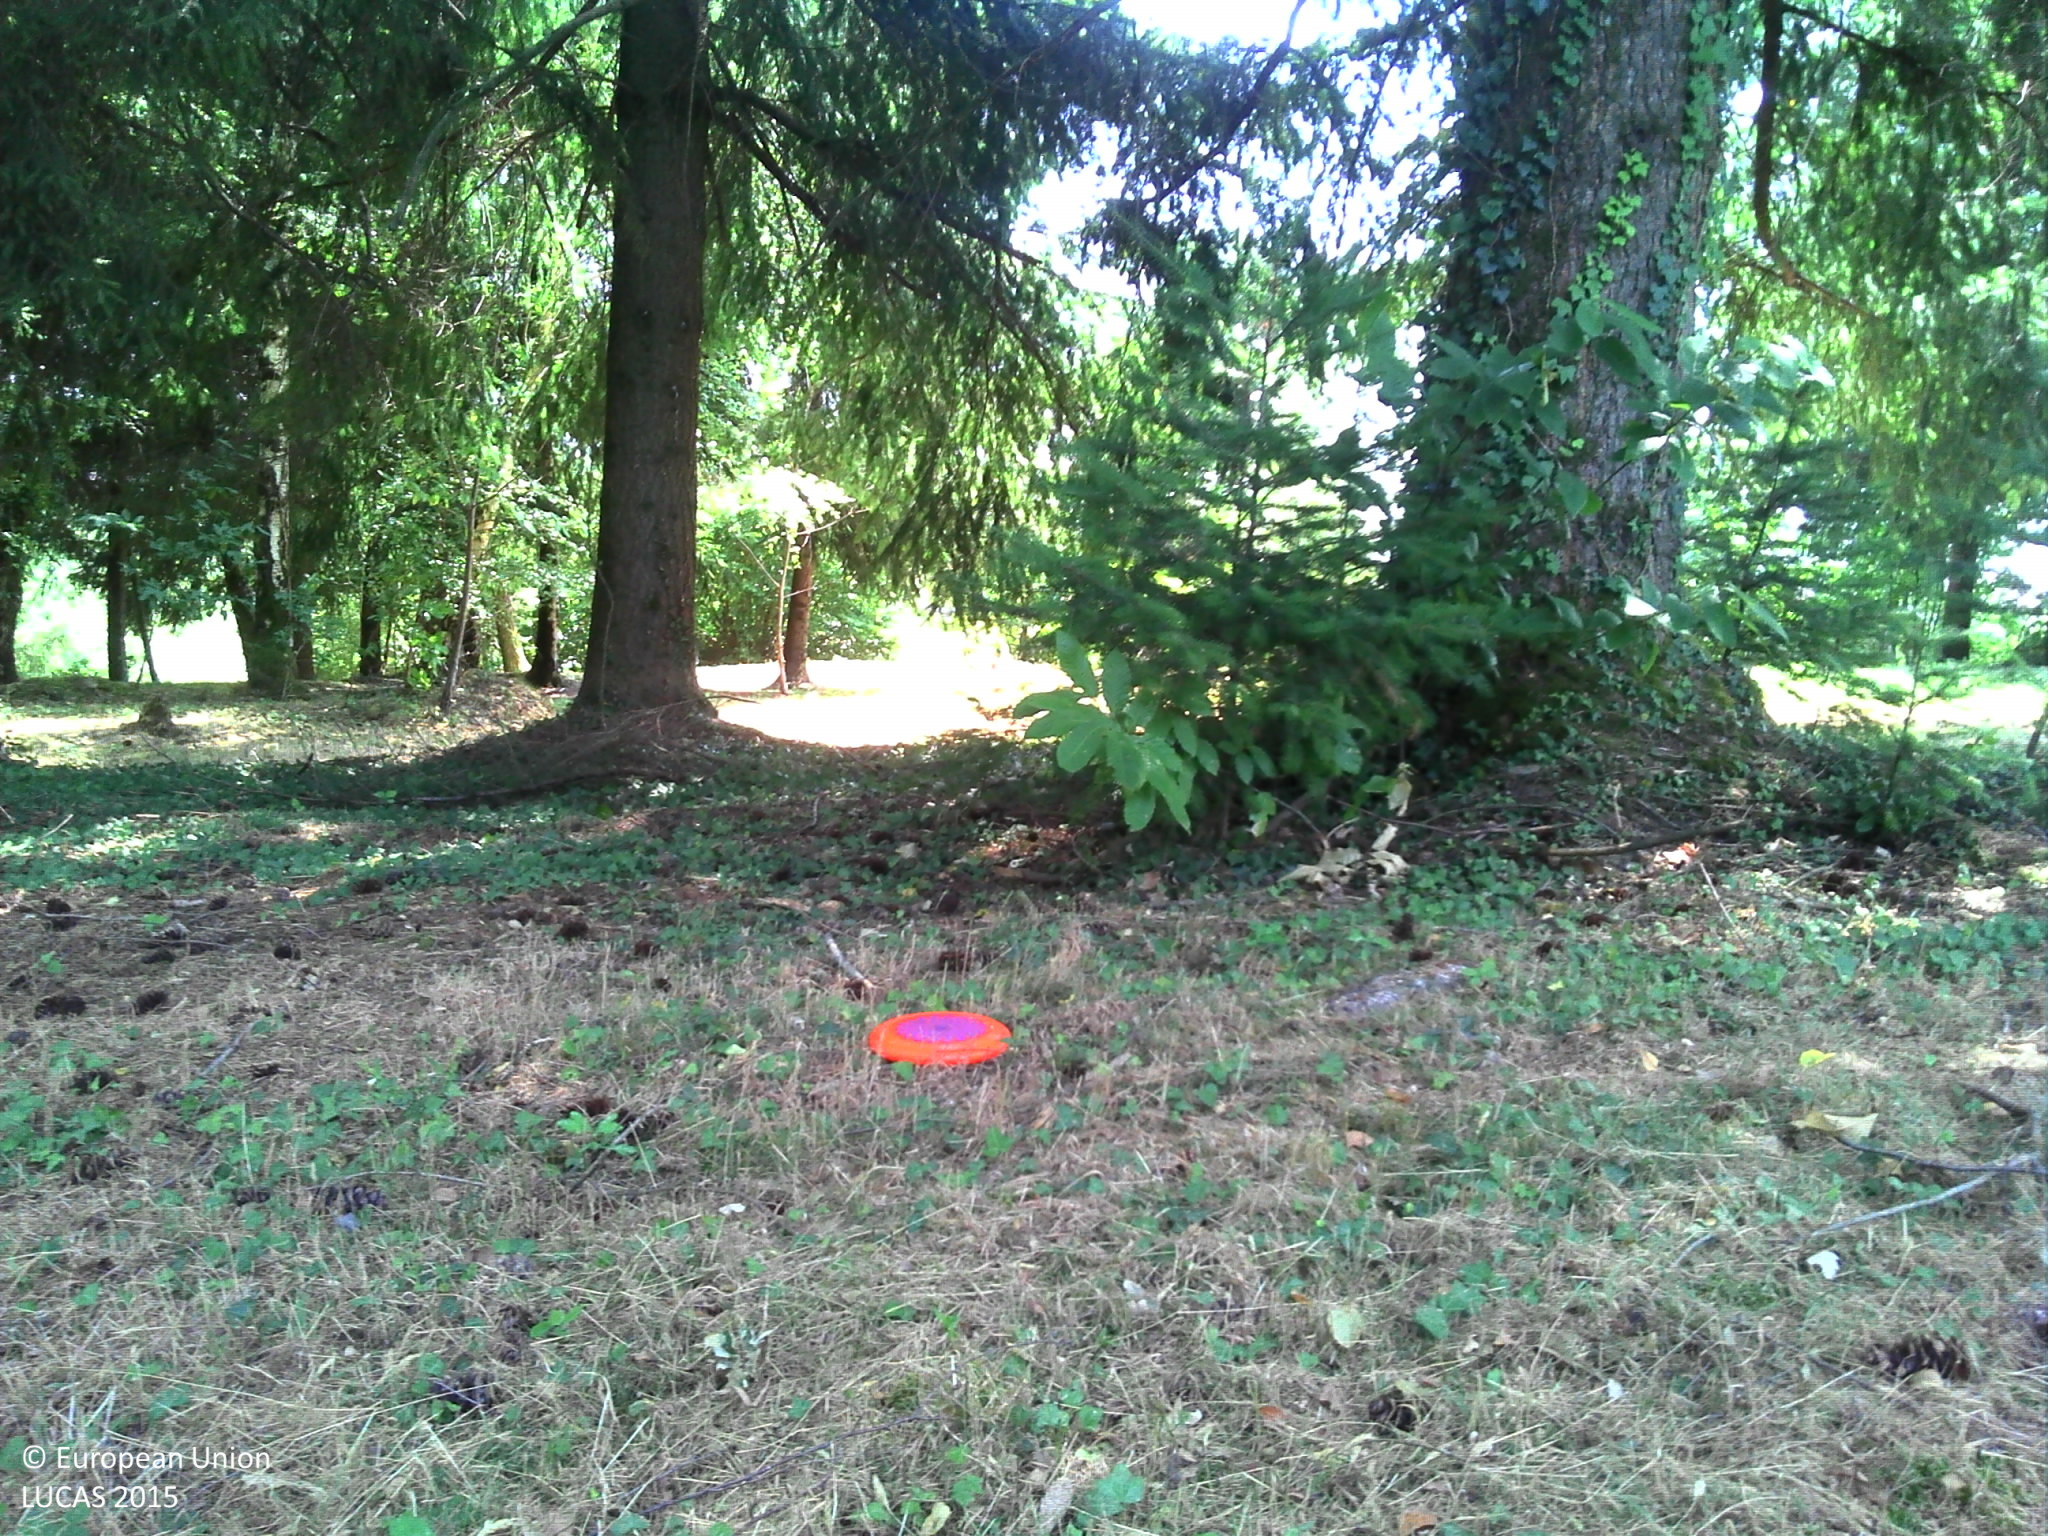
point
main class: Woodland
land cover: Other mixed woodland
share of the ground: > 75 %
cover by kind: broadleaved forest trees 55 %, coniferous forest trees 25 %, herbaceous plants 20 %
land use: Residential
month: July
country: FR
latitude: 45.6110
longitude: 1.0271
